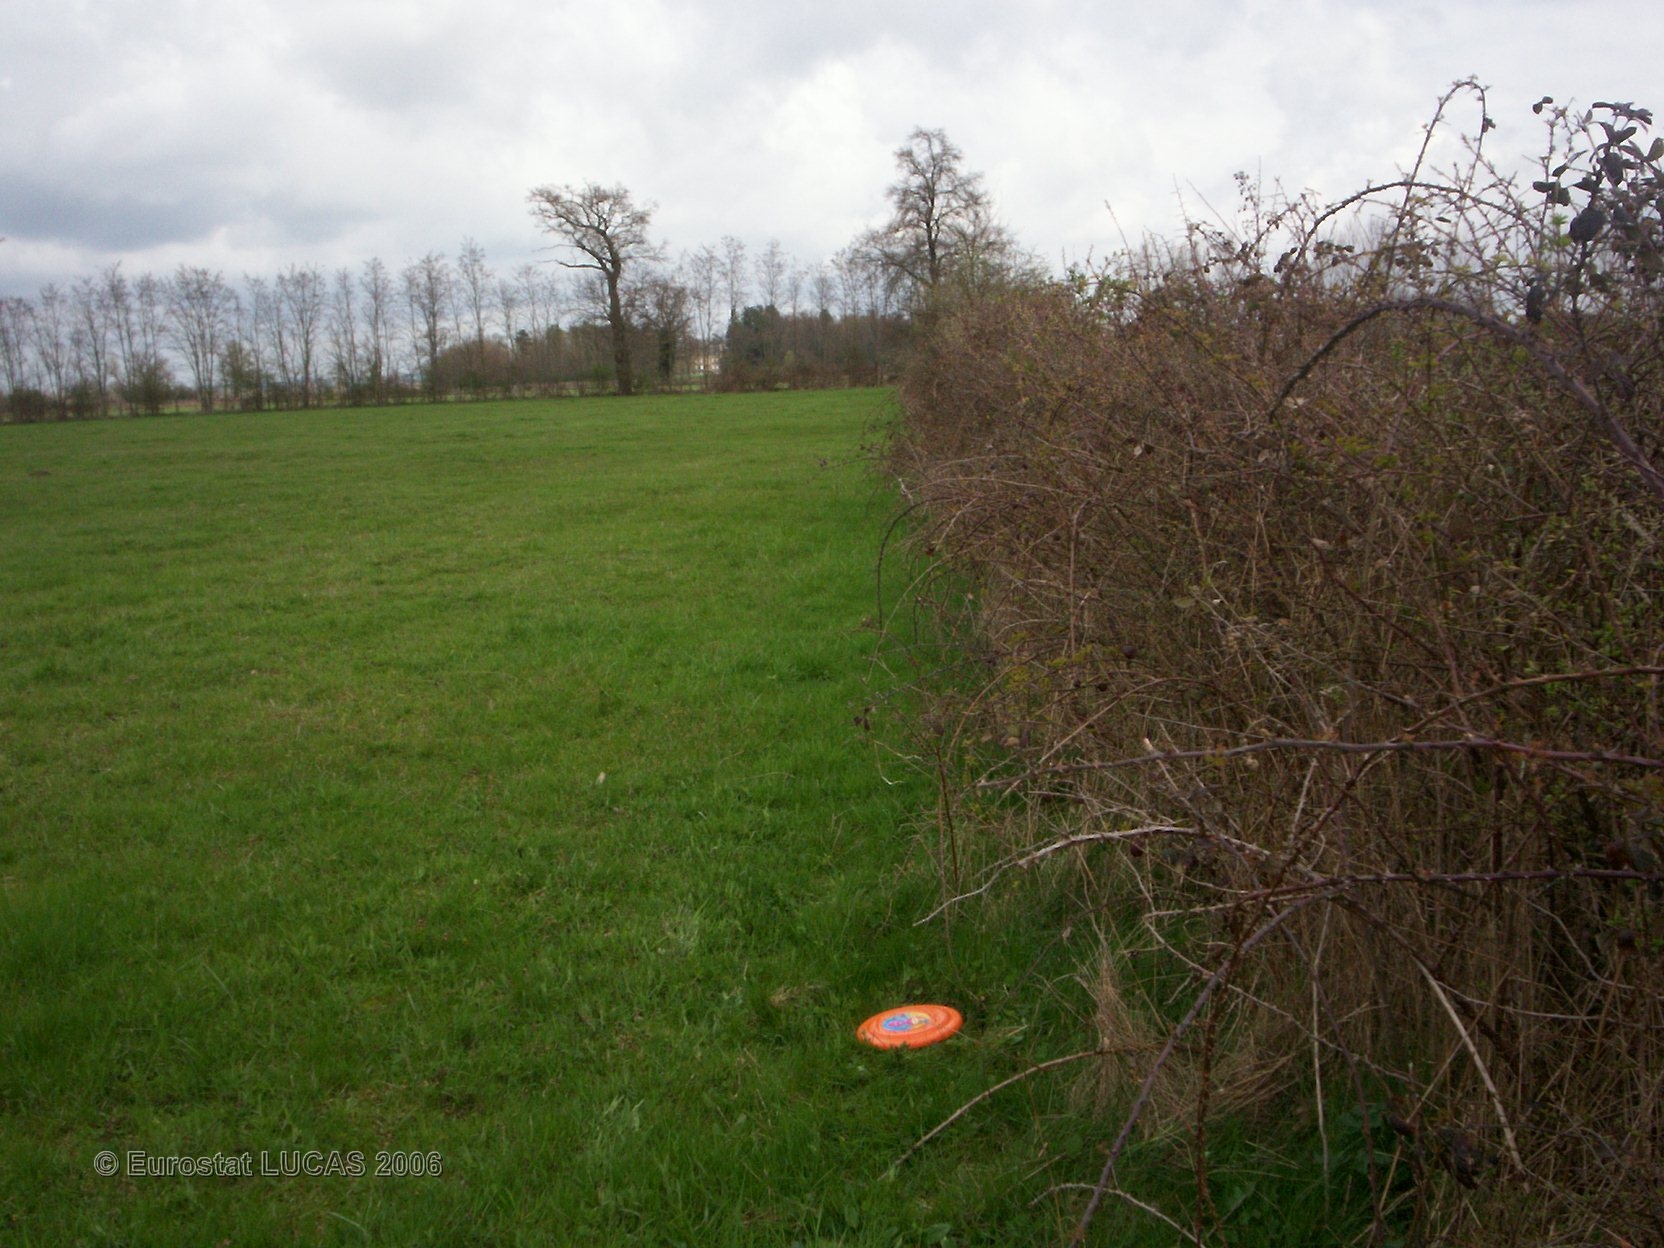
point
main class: Grassland
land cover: Grassland without tree/shrub cover
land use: Agriculture (excluding fallow land and kitchen gardens)
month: April
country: FR
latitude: 46.8323
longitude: 3.0874
